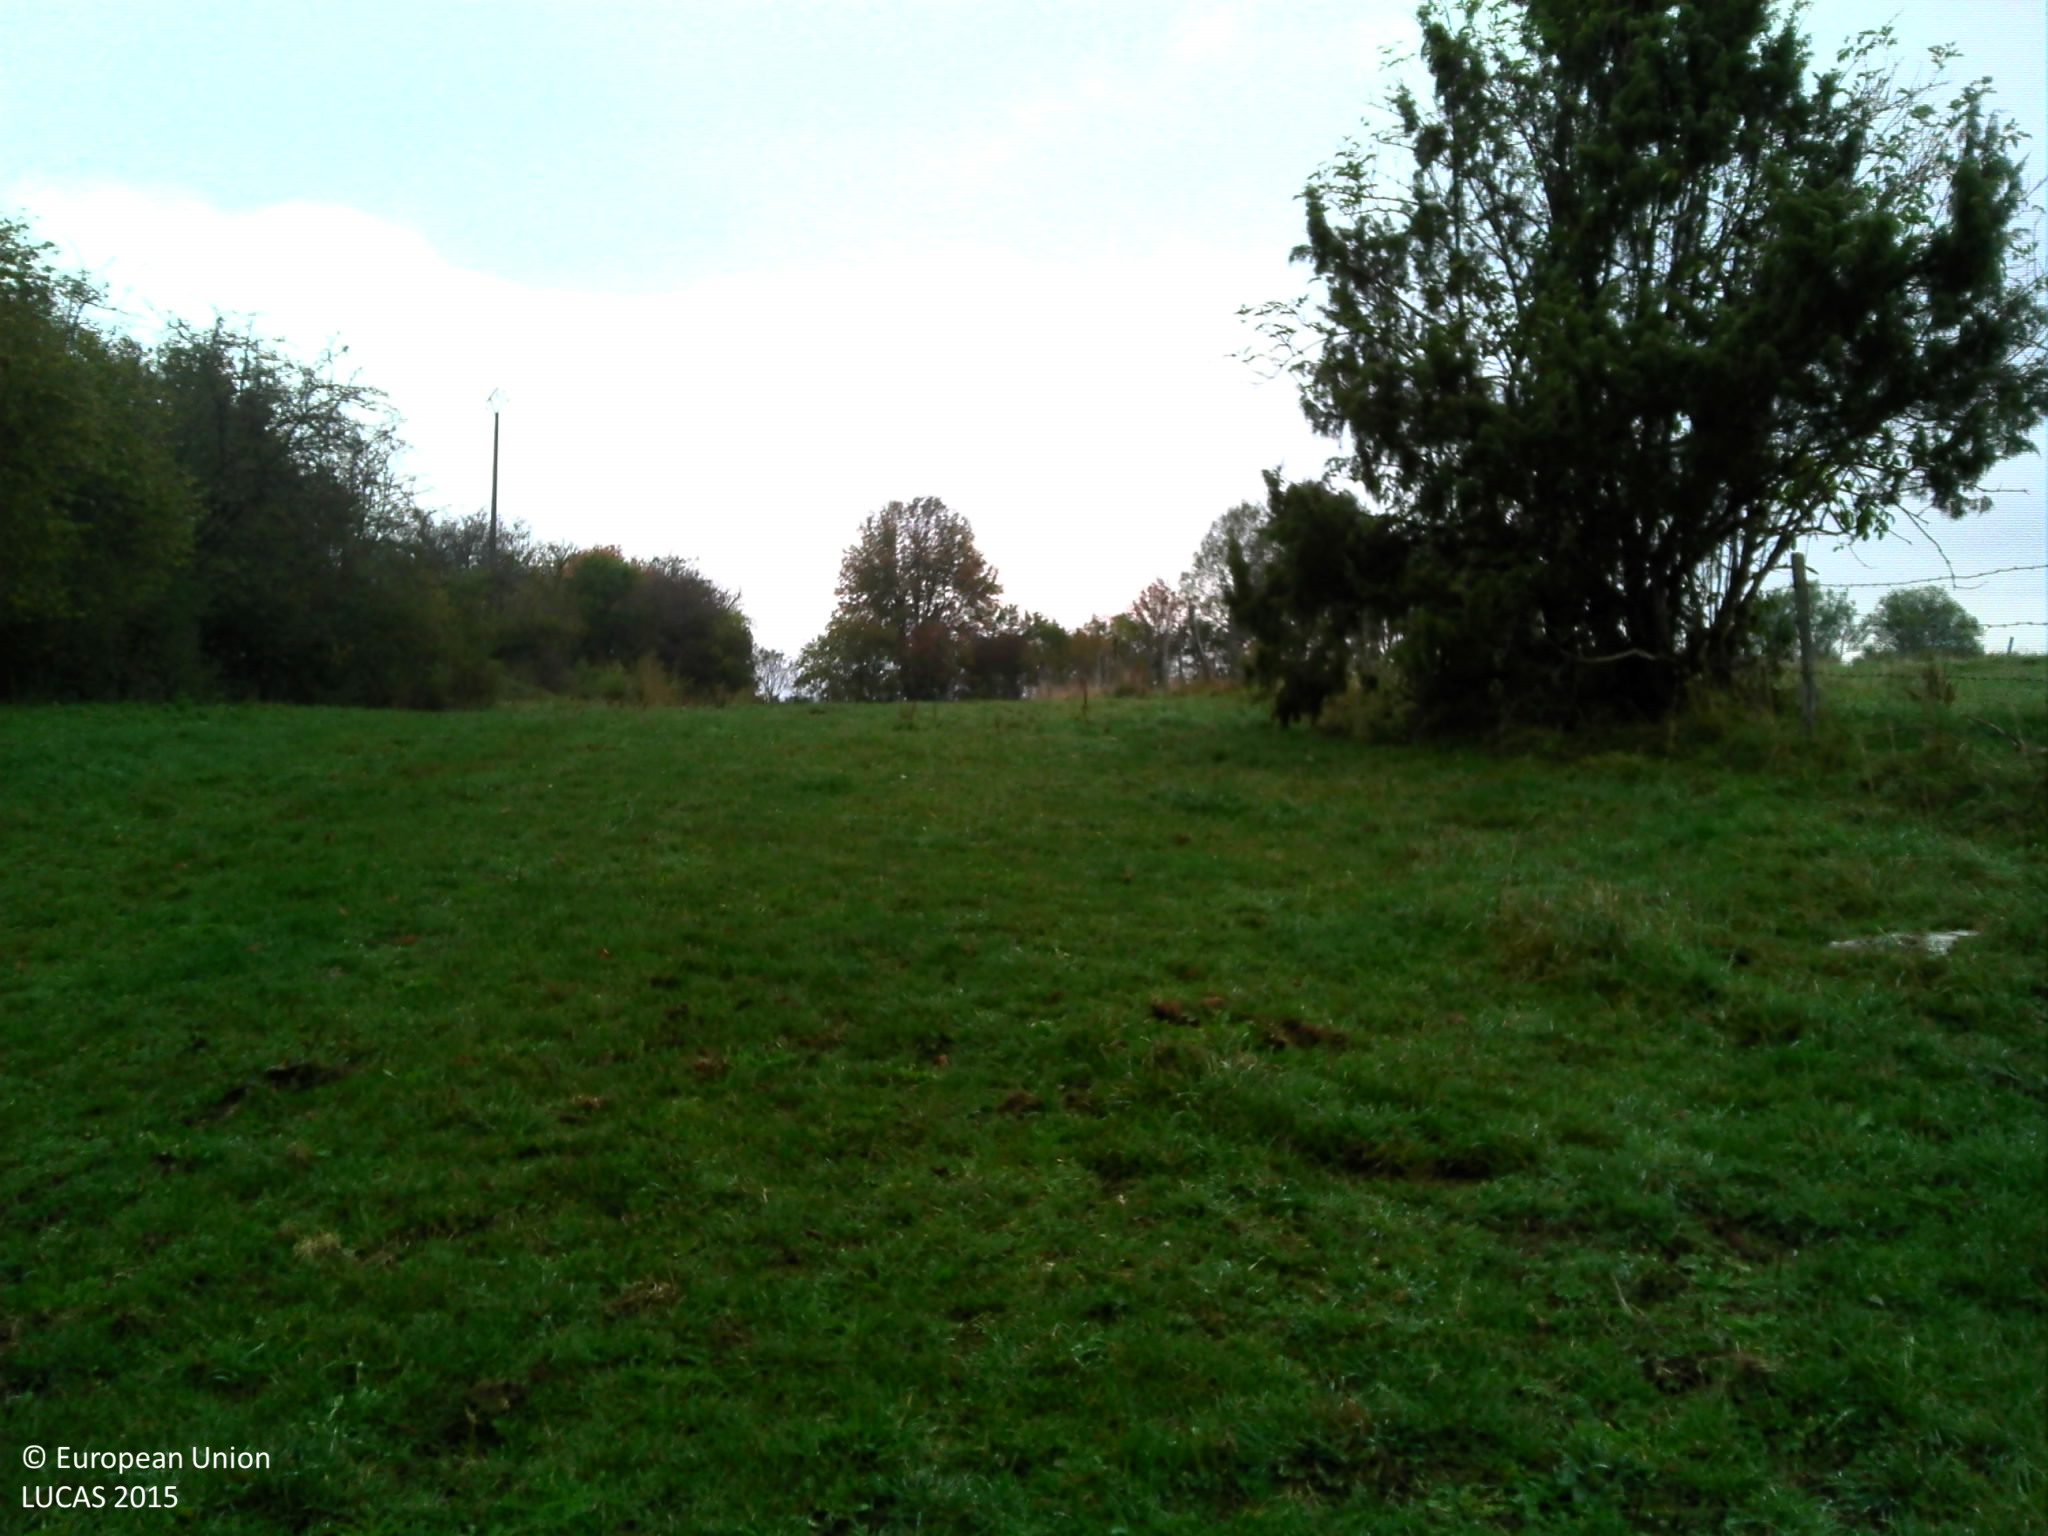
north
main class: Grassland
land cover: Grassland without tree/shrub cover
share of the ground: > 75 %
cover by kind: herbaceous plants 100 %
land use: Agriculture (excluding fallow land and kitchen gardens)
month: October
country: FR
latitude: 46.8818
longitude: 6.2888
